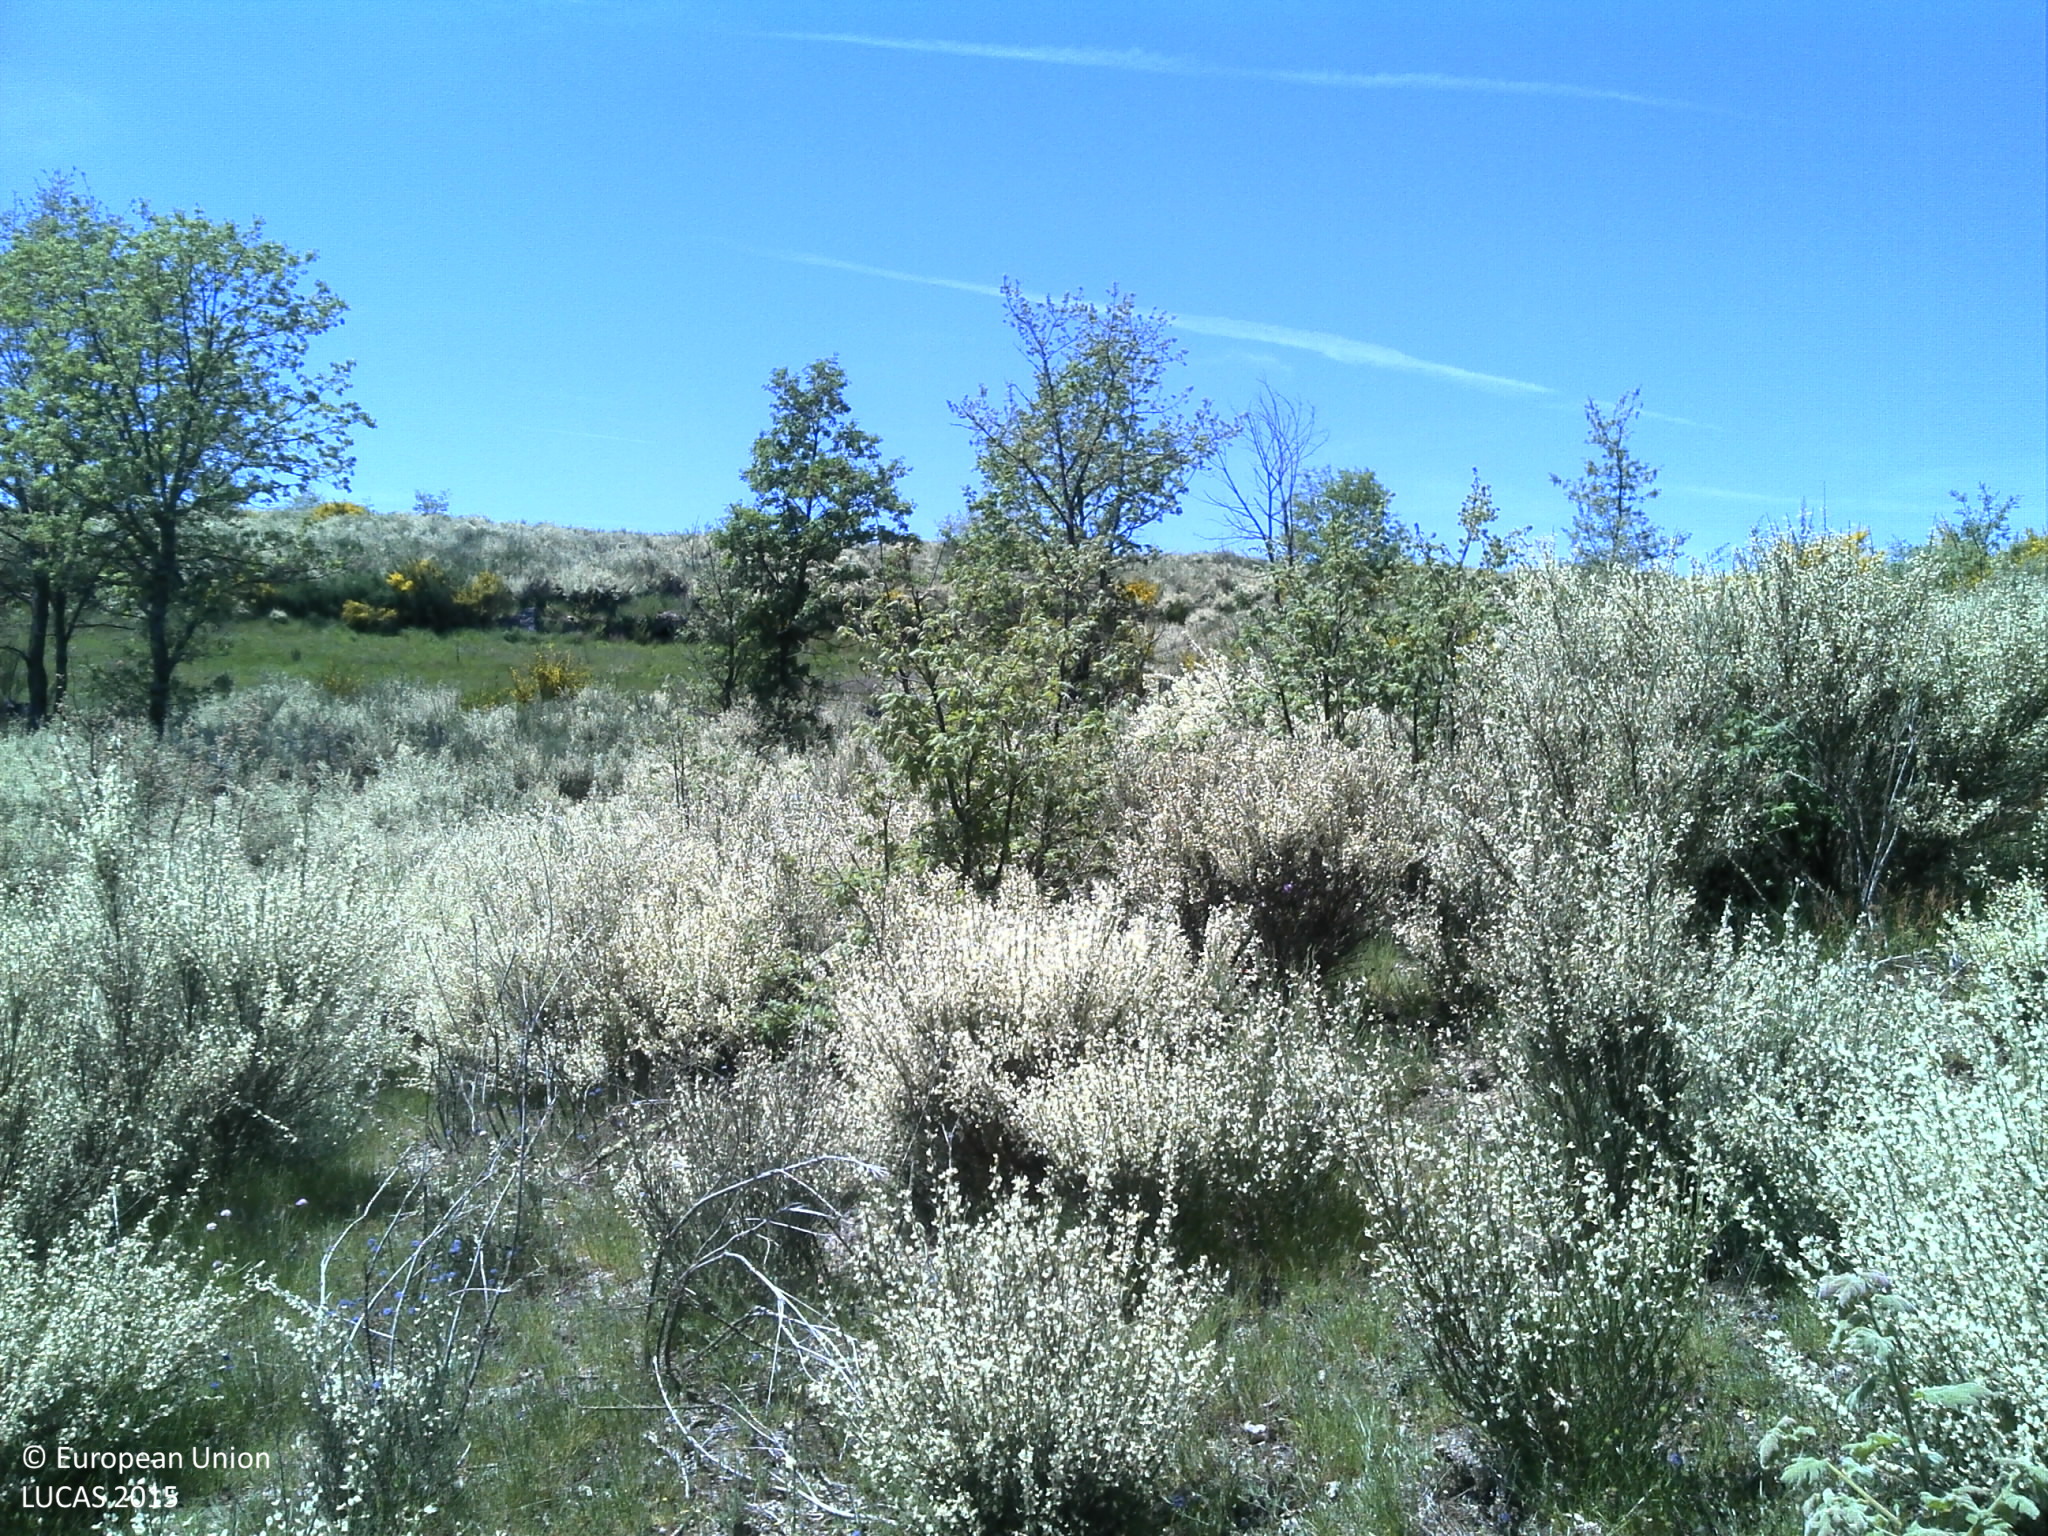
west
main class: Shrubland
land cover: Shrubland with sparse tree cover
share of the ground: 50 - 75 %
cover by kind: shrubs 75 %, unconsolidated bare surface 20 %, broadleaved forest trees 5 %
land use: Semi-natural and natural areas not in use
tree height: < 5 m
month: May
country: PT
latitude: 41.0279
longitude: -7.8870
